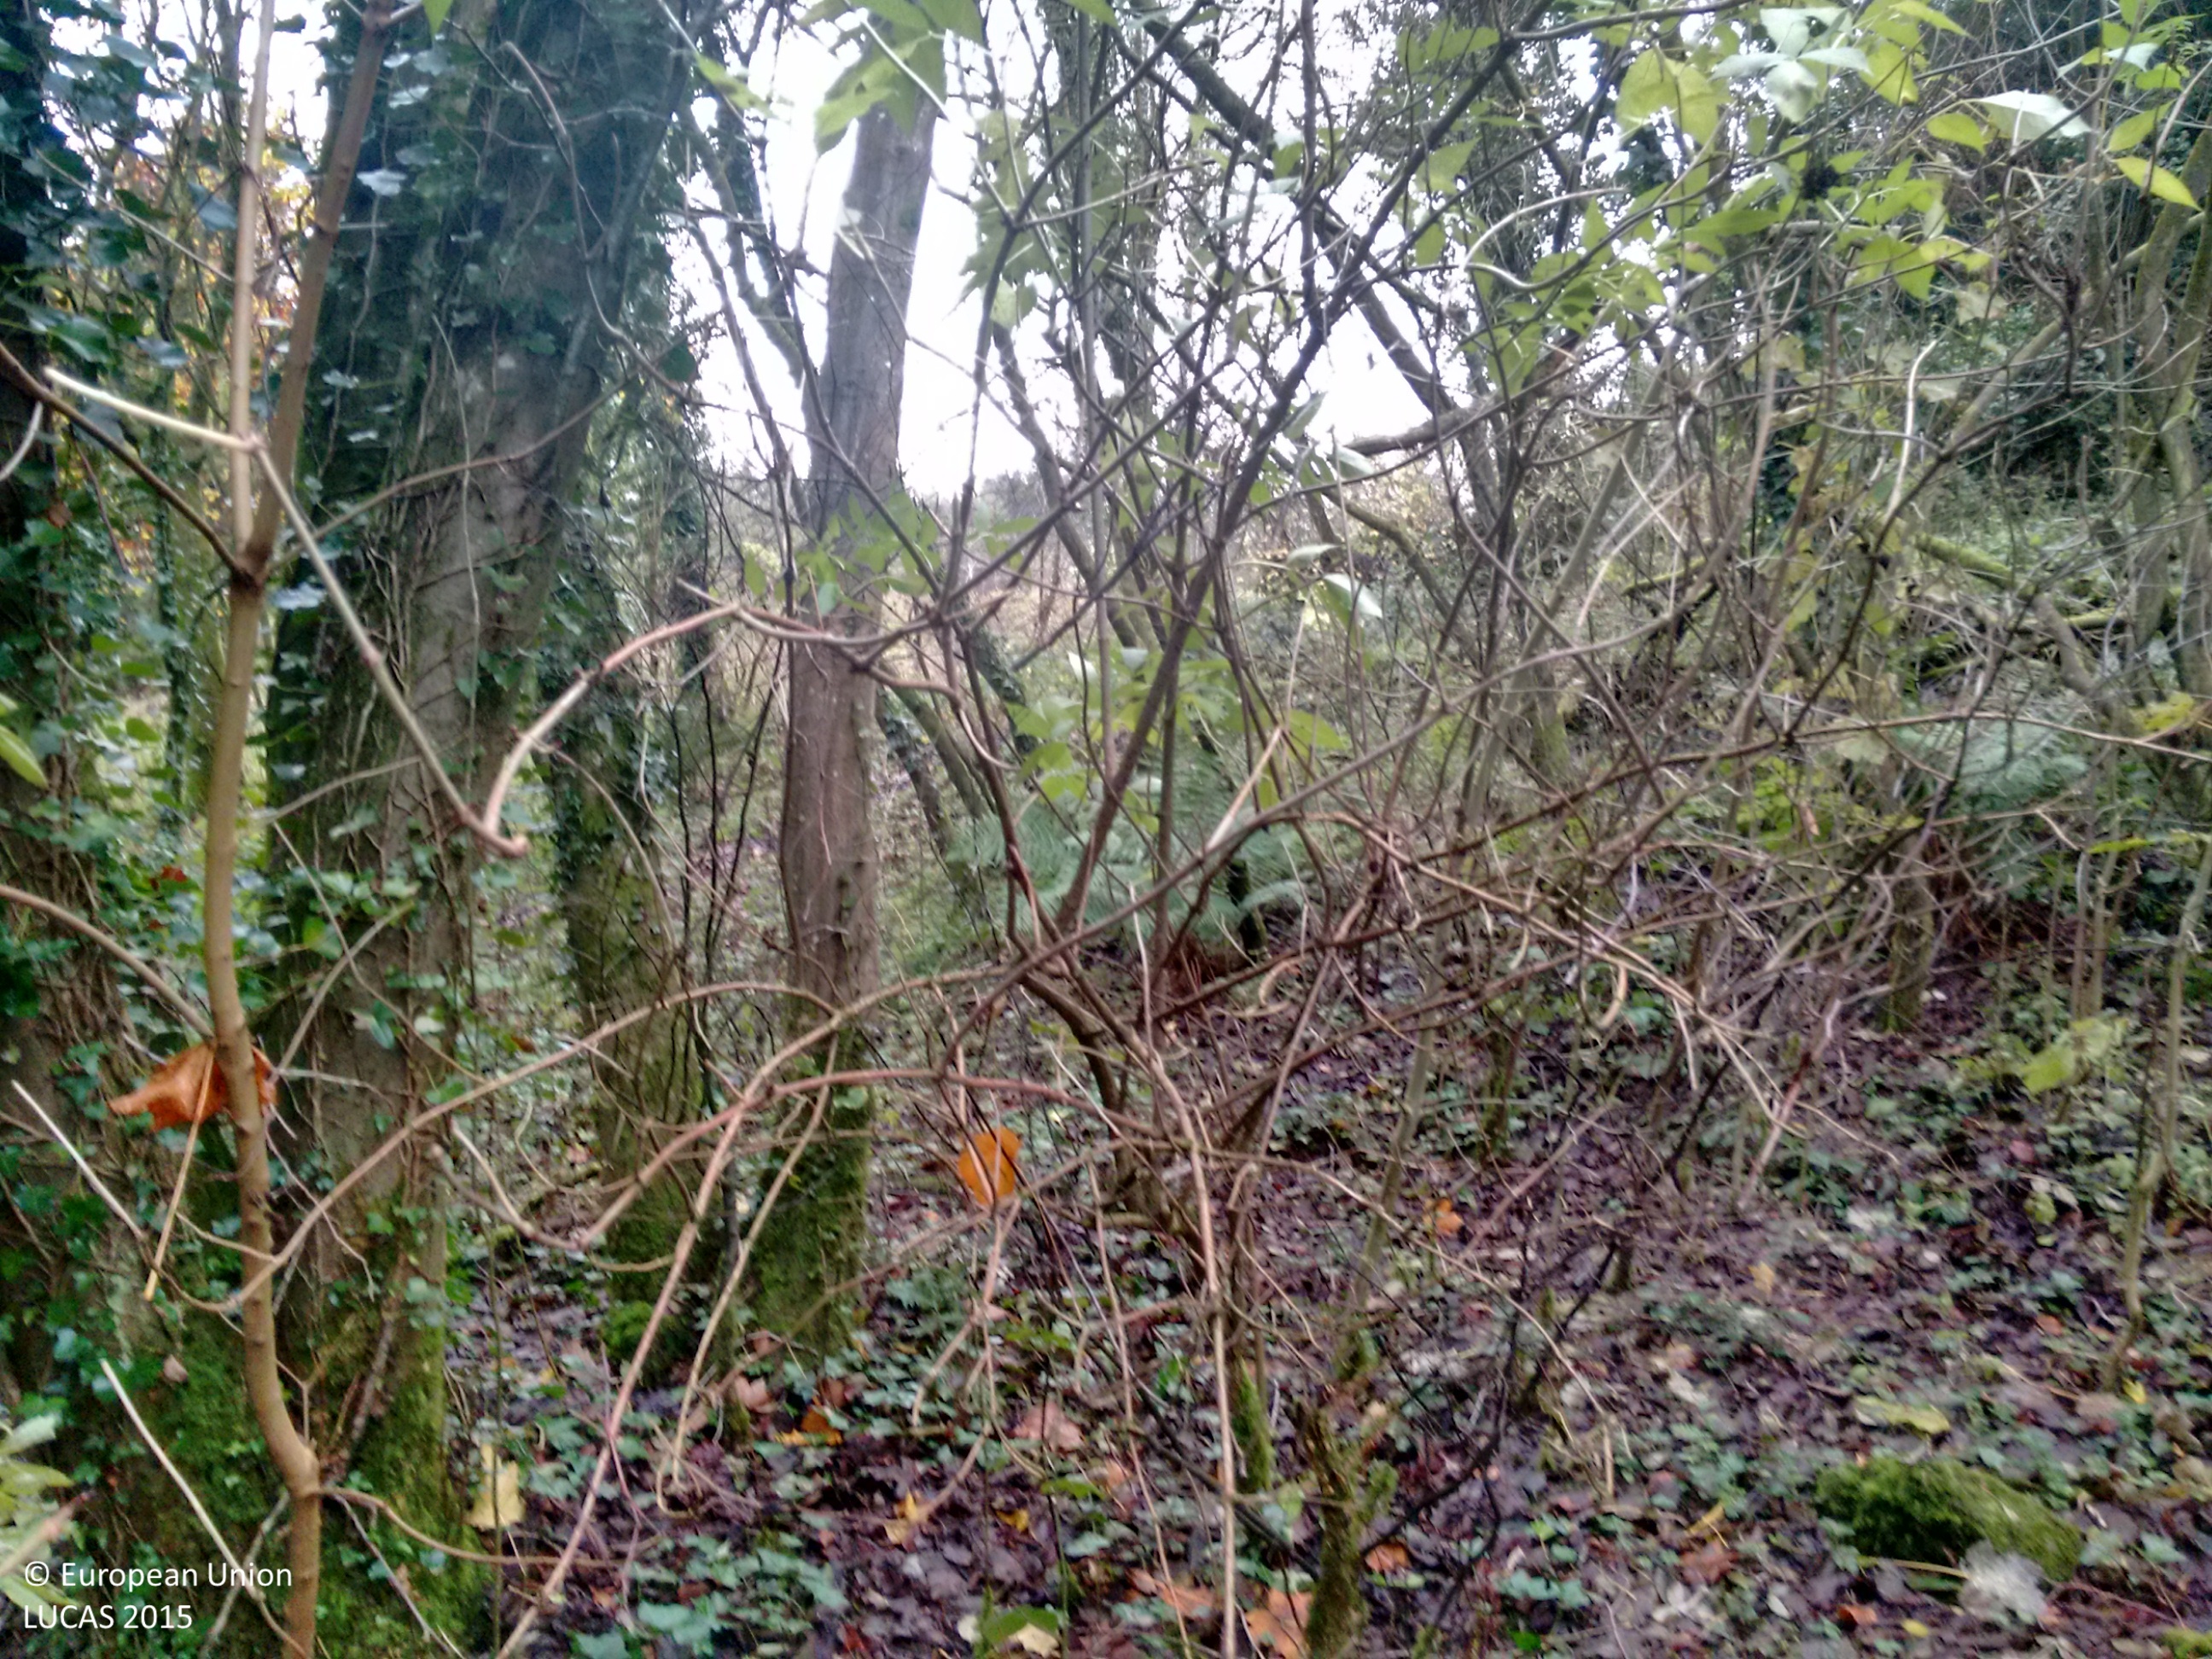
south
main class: Woodland
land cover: Other mixed woodland
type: exotic forest
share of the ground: > 75 %
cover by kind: broadleaved forest trees 60 %, coniferous forest trees 30 %, herbaceous plants 10 %
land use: Amenities, museums, leisure
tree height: > 5 m
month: November
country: GB
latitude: 54.5589
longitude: -5.9271
